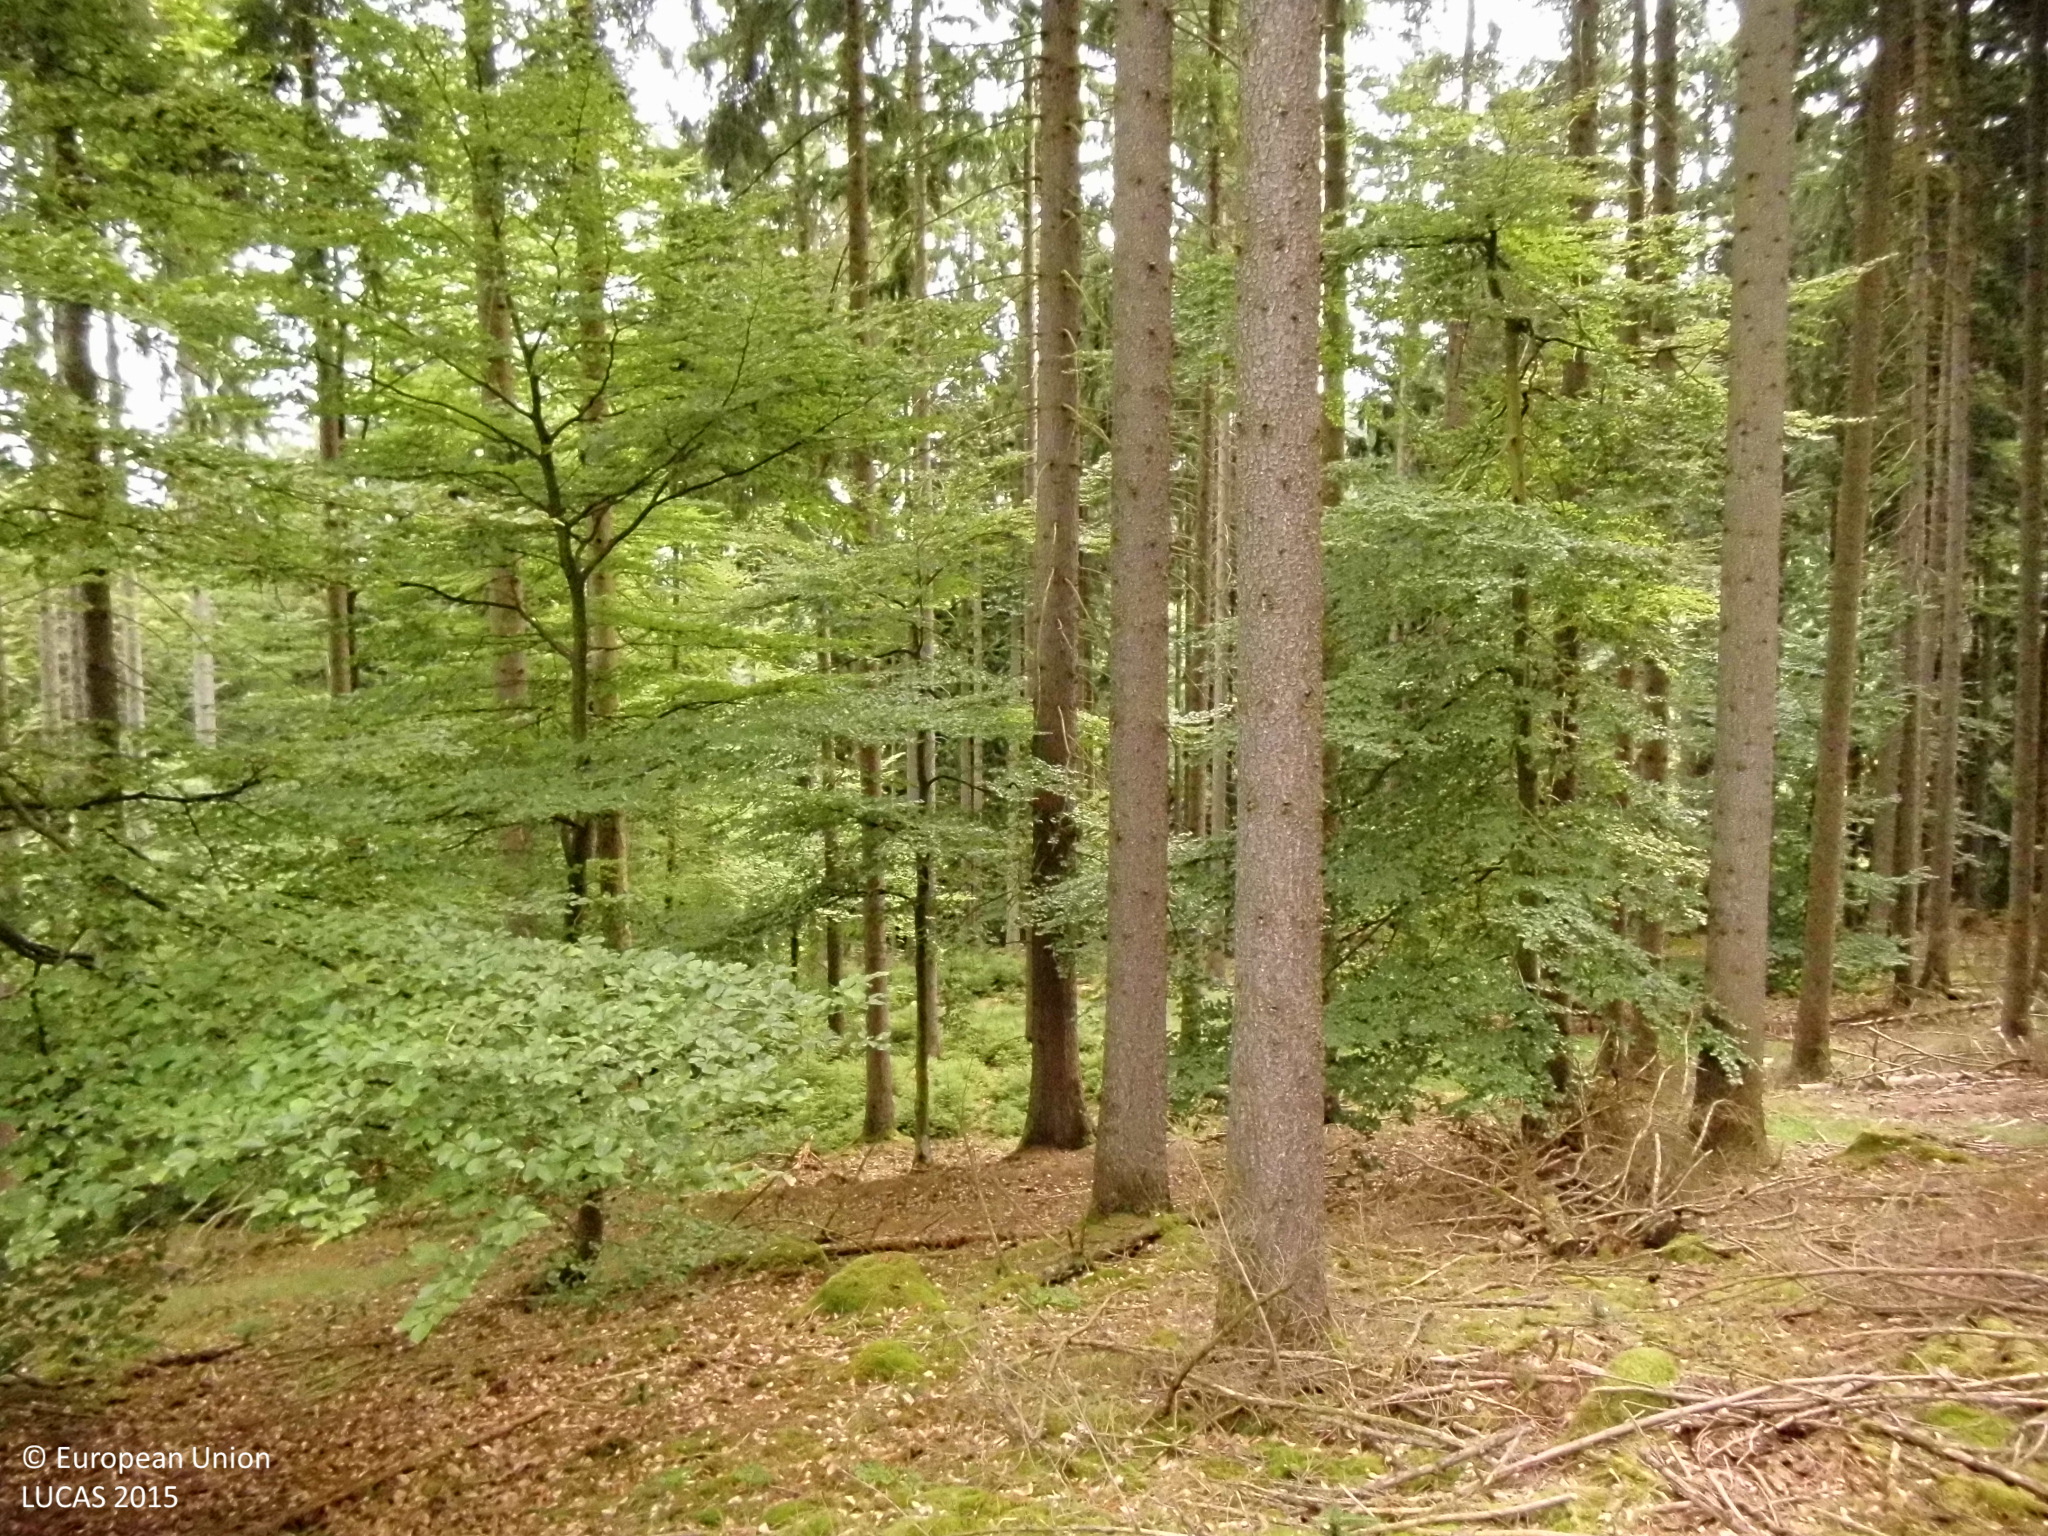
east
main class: Woodland
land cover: Spruce dominated coniferous woodland
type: hemiboreal forest and nemoral coniferous forest and mixed broadleaved-coniferous forest
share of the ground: > 75 %
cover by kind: coniferous forest trees 65 %, broadleaved forest trees 15 %, lichens and mosses 10 %, shrubs 5 %, unconsolidated bare surface 5 %
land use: Forestry
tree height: > 5 m
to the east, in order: Spruce dominated coniferous woodland; Tracks; Spruce dominated mixed woodland; Spruce dominated coniferous woodland; Tracks; Spruce dominated mixed woodland; Grassland without tree/shrub cover; Broadleaved woodland; Tracks; Groves; Grassland without tree/shrub cover; Ditches and canals; Tracks; Shruby margins; Ditches and canals; Broadleaved woodland; Spontaneously vegetated surfaces; Tracks; Pine dominated mixed woodland
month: August
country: DE
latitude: 50.9847
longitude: 8.5901
